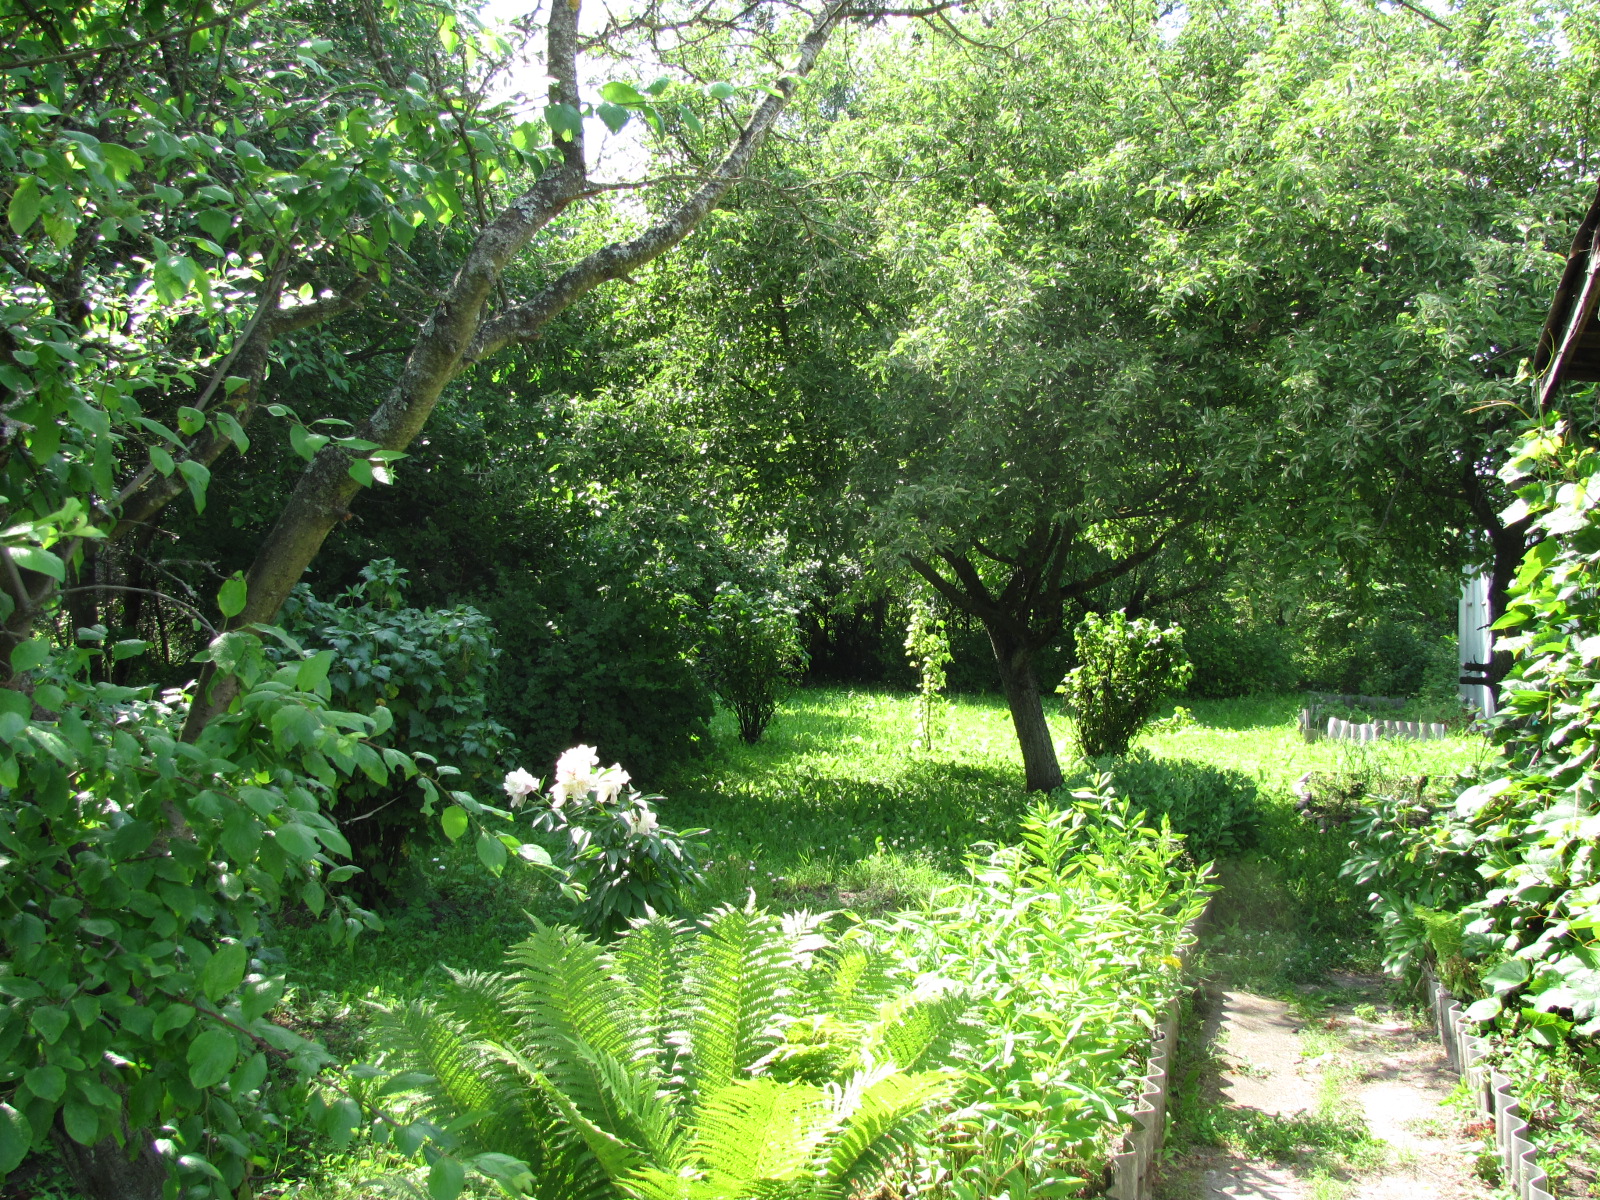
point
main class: Cropland
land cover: Cherry fruit
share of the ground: 50 - 75 %
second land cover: Grassland without tree/shrub cover
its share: > 75 %
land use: Kitchen garden
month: July
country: LV
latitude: 56.9185
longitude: 24.1309
